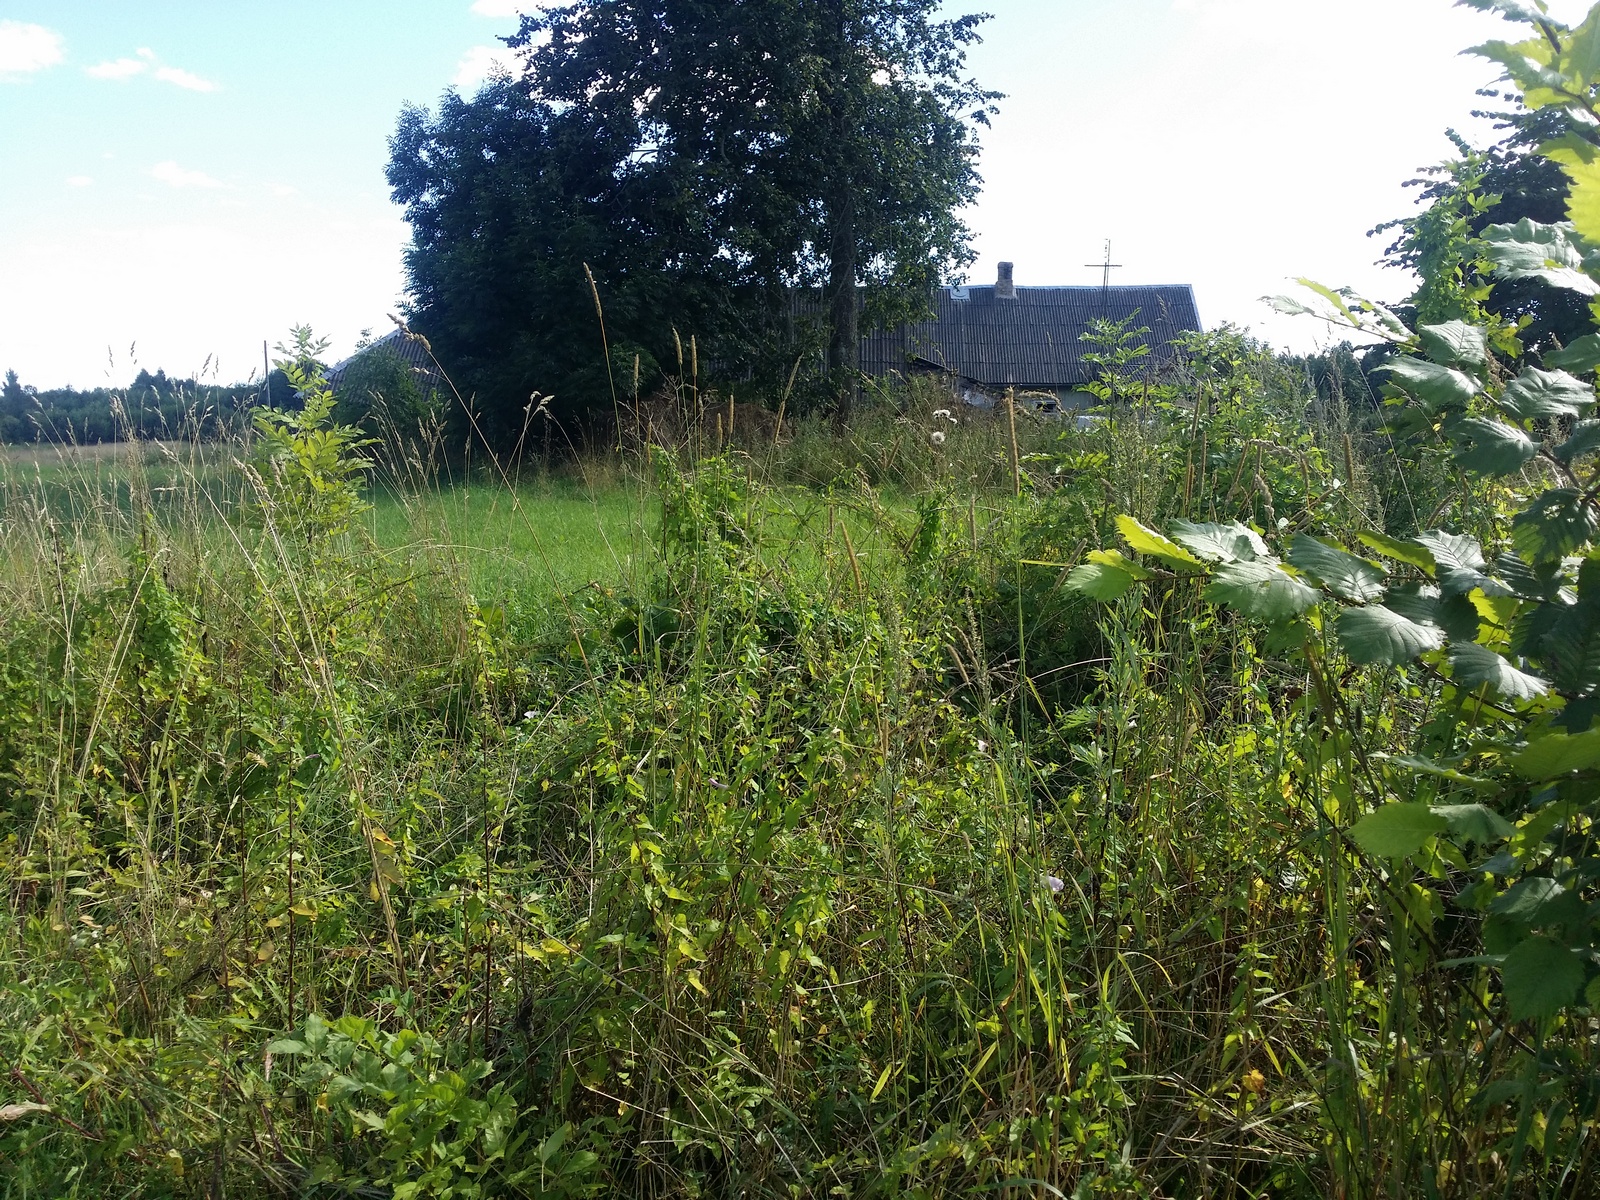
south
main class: Grassland
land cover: Grassland without tree/shrub cover
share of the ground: > 75 %
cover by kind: herbaceous plants 100 %
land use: Agriculture (excluding fallow land and kitchen gardens)
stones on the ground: < 10 %
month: August
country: LV
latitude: 56.9692
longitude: 27.5998
